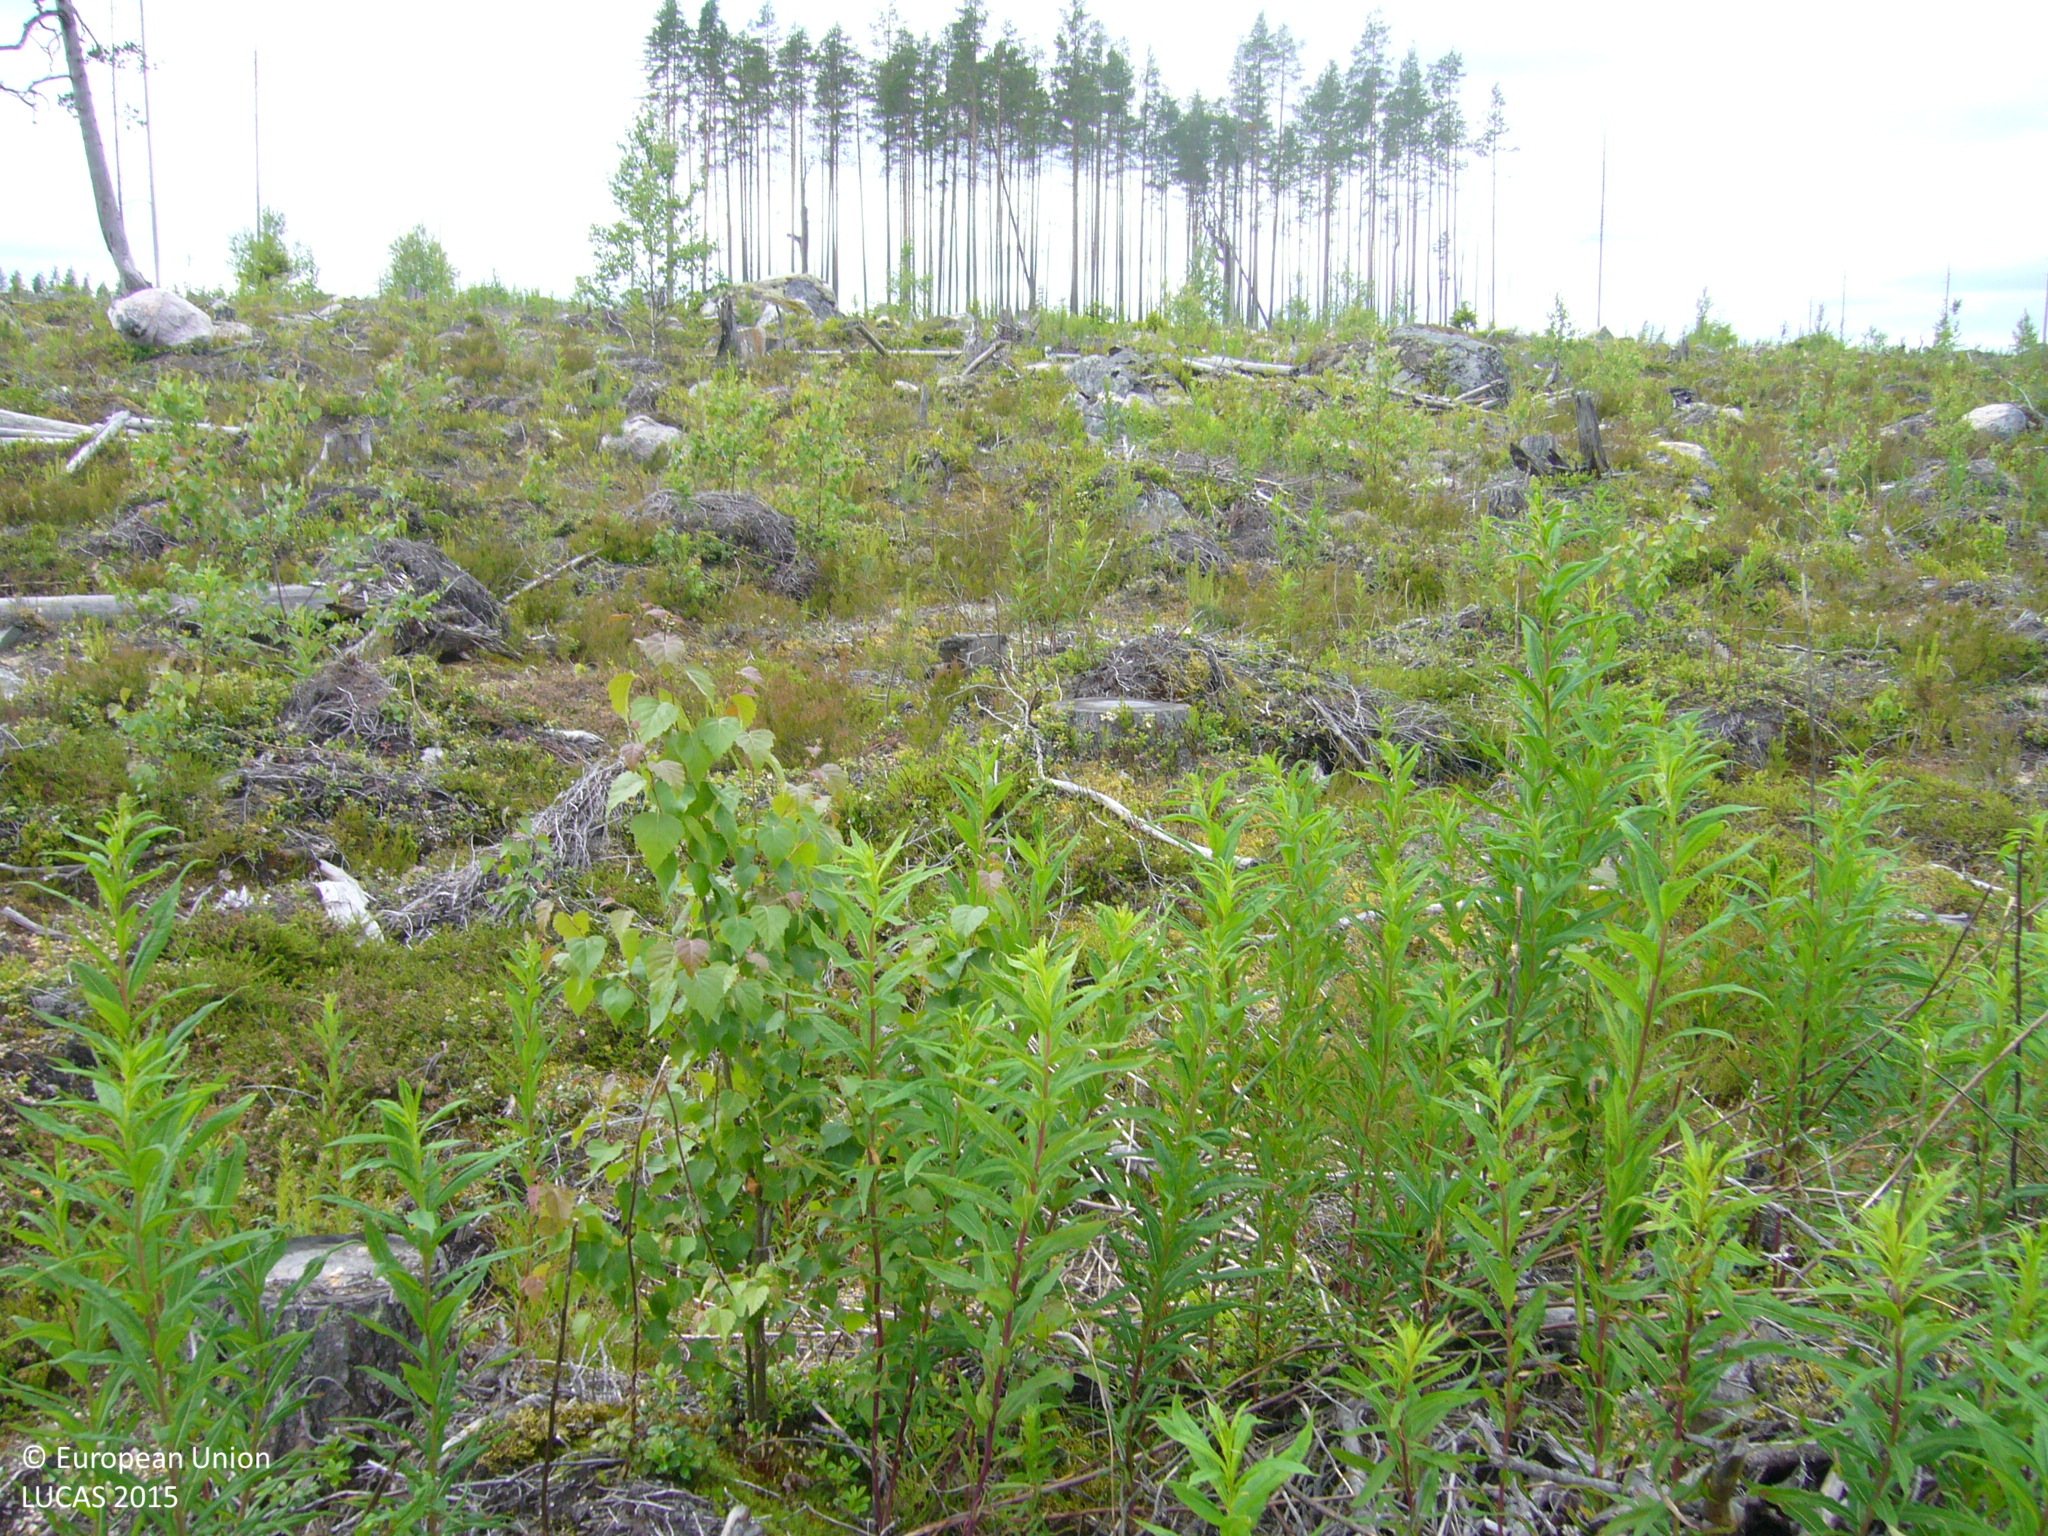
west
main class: Shrubland
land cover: Shrubland with sparse tree cover
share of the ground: > 75 %
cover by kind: shrubs 85 %, broadleaved forest trees 5 %
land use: Forestry
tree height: < 5 m
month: July
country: FI
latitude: 63.4133
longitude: 26.1604
